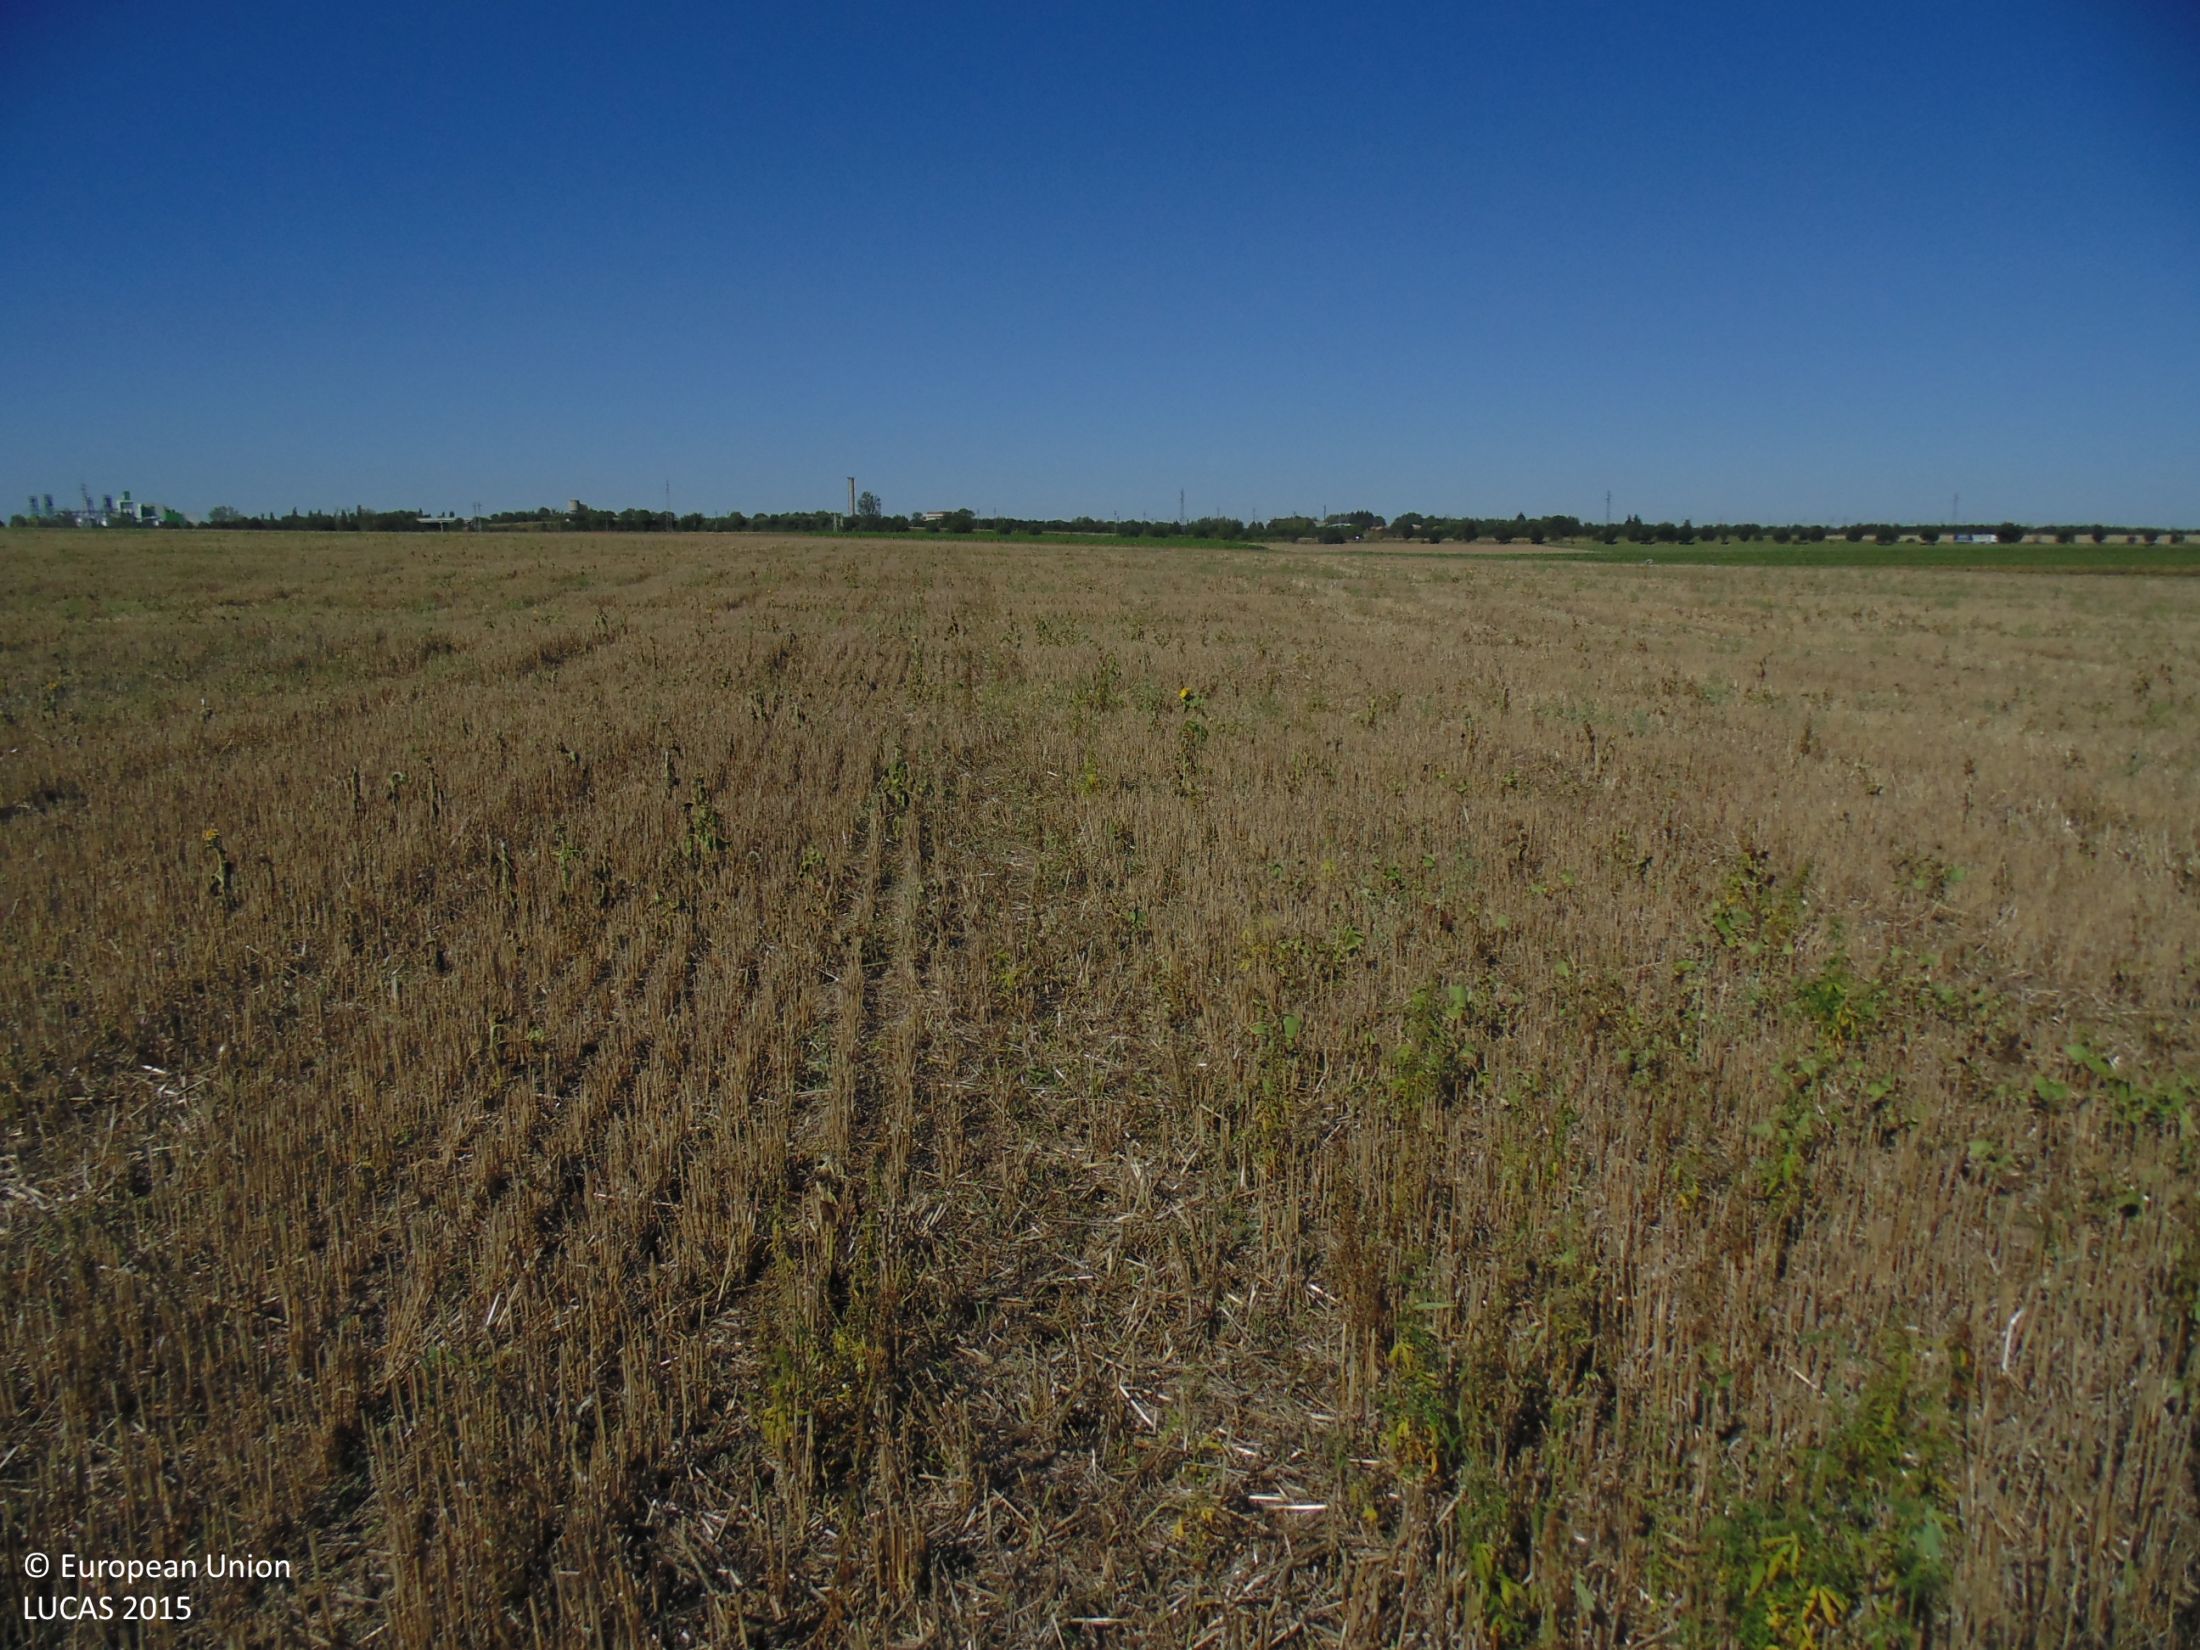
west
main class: Cropland
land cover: Common wheat
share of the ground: 50 - 75 %
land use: Agriculture (excluding fallow land and kitchen gardens)
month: September
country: BG
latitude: 43.8086
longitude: 27.1685
